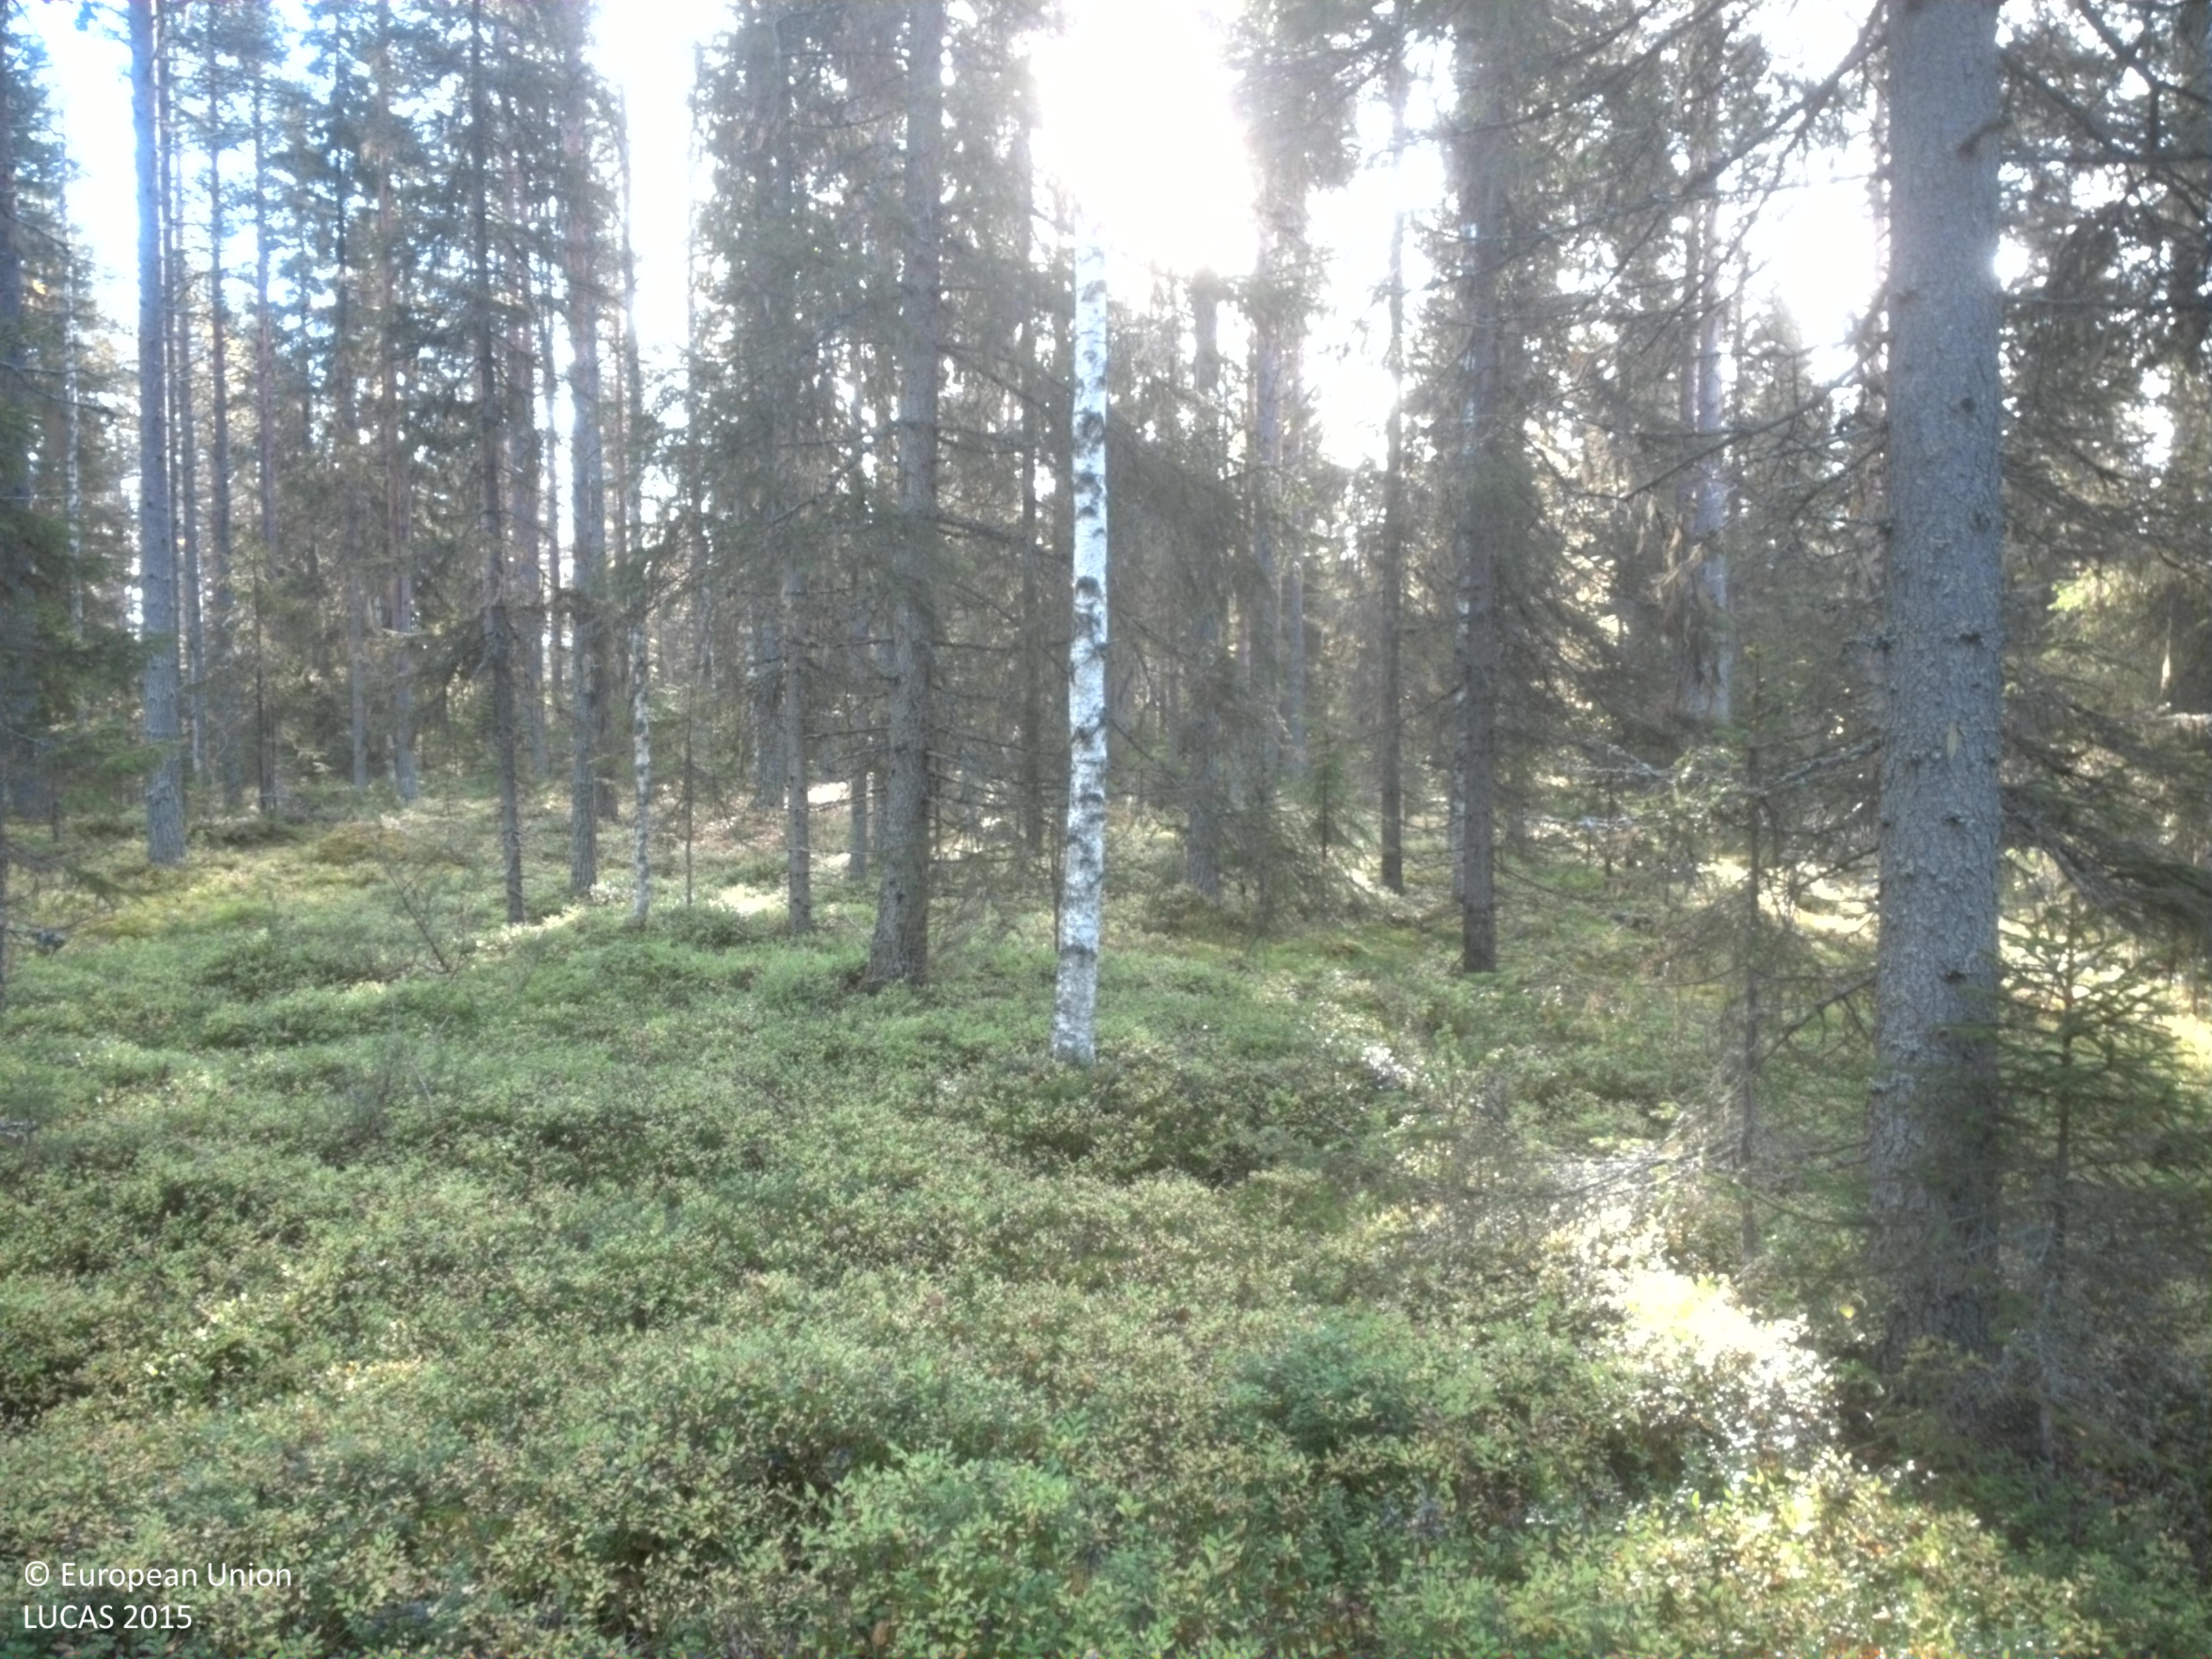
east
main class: Woodland
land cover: Spruce dominated coniferous woodland
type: boreal forest
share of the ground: 50 - 75 %
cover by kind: coniferous forest trees 55 %, shrubs 35 %, broadleaved forest trees 5 %, lichens and mosses 5 %
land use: Forestry
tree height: > 5 m
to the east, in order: Spruce dominated coniferous woodland; Other coniferous woodland; Spruce dominated coniferous woodland; Rivers and streams; Spruce dominated coniferous woodland; Pine dominated mixed woodland; Other mixed woodland; Pine dominated coniferous woodland
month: September
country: SE
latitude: 64.2523
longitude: 19.8998
